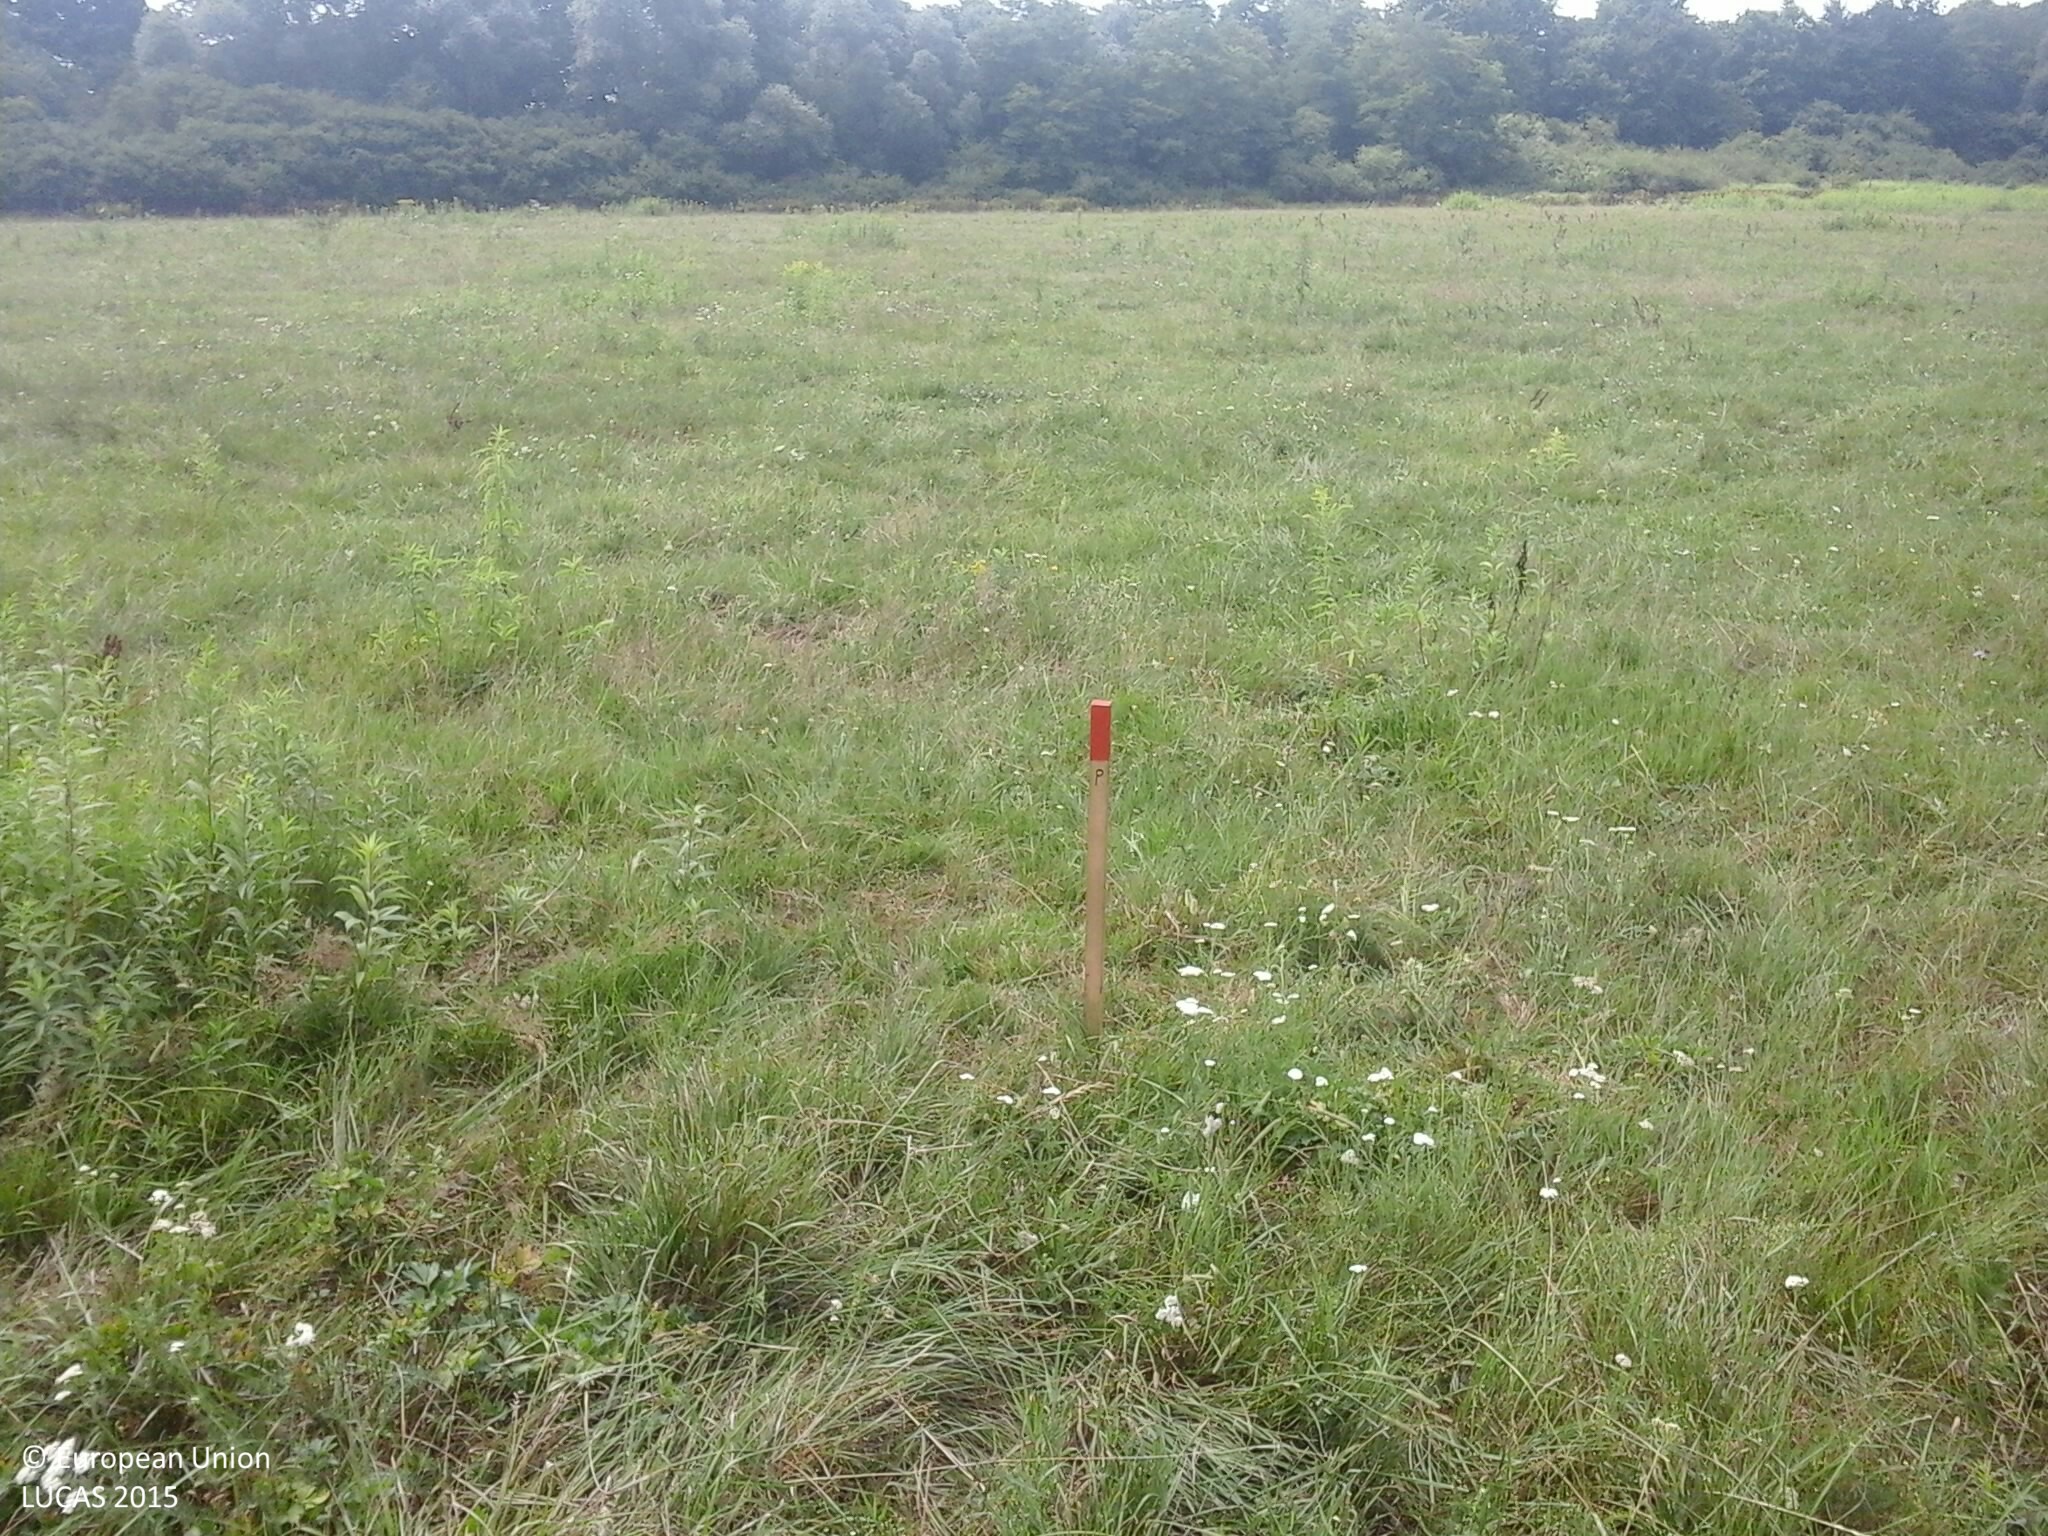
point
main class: Grassland
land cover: Grassland without tree/shrub cover
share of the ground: > 75 %
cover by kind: herbaceous plants 100 %
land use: Agriculture (excluding fallow land and kitchen gardens)
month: July
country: HU
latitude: 47.0407
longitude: 16.4646
